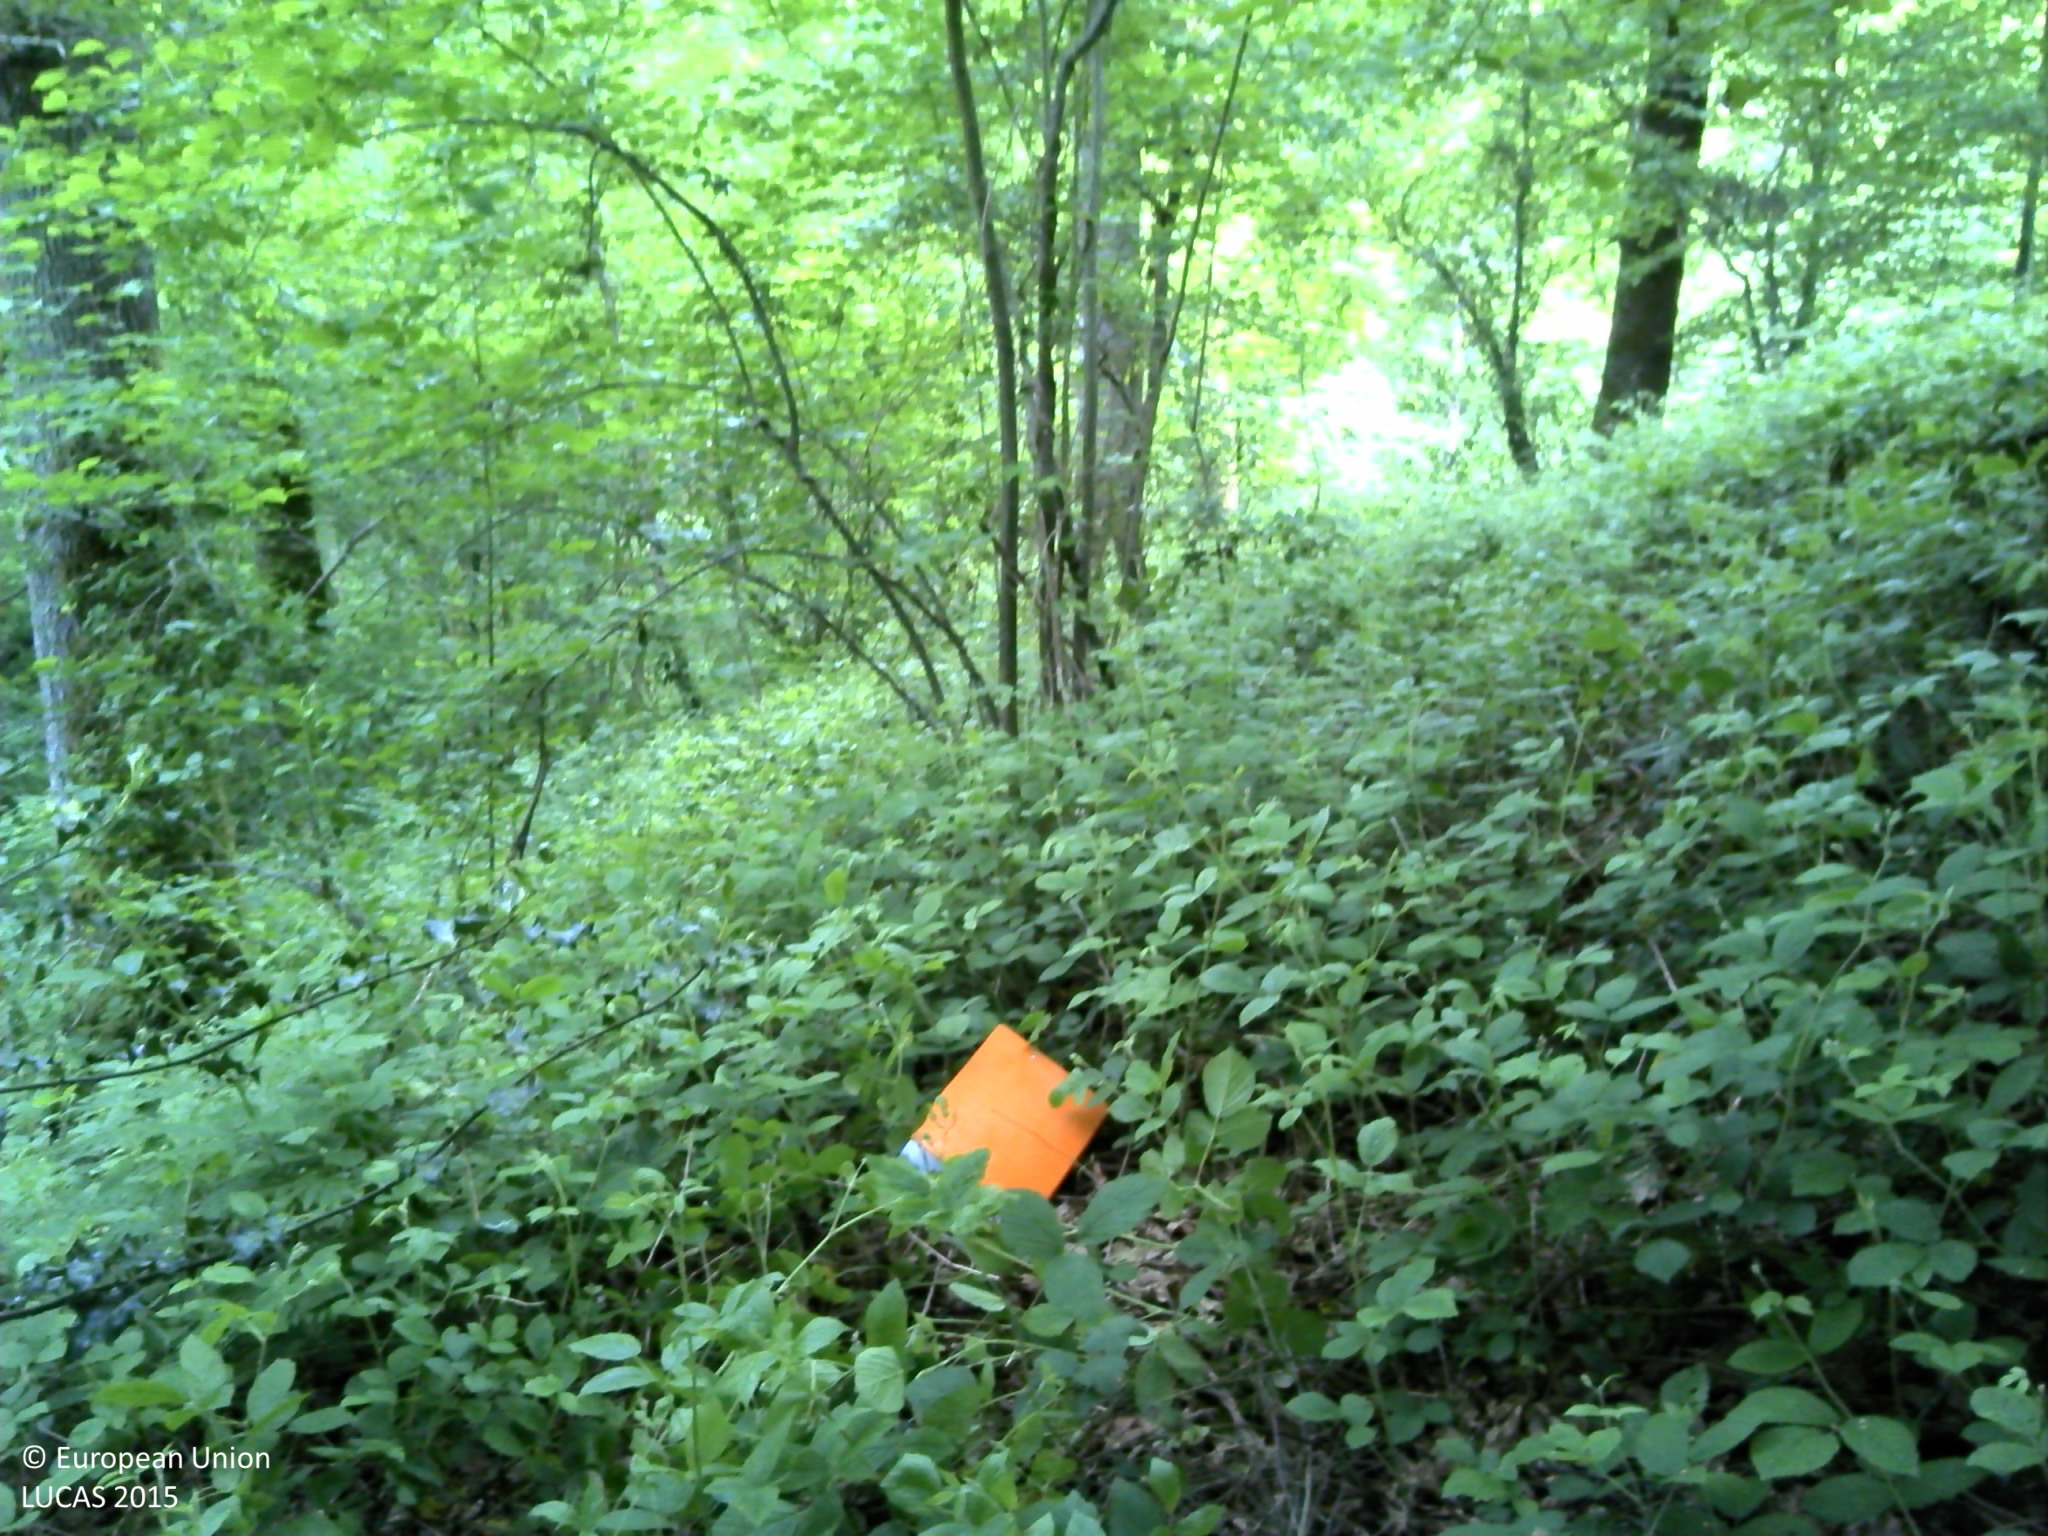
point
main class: Woodland
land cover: Broadleaved woodland
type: acidophilous oak and oak-birch forest
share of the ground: > 75 %
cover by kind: broadleaved forest trees 85 %, herbaceous plants 15 %
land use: Forestry
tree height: > 5 m
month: June
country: FR
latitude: 49.5746
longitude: 1.0025
